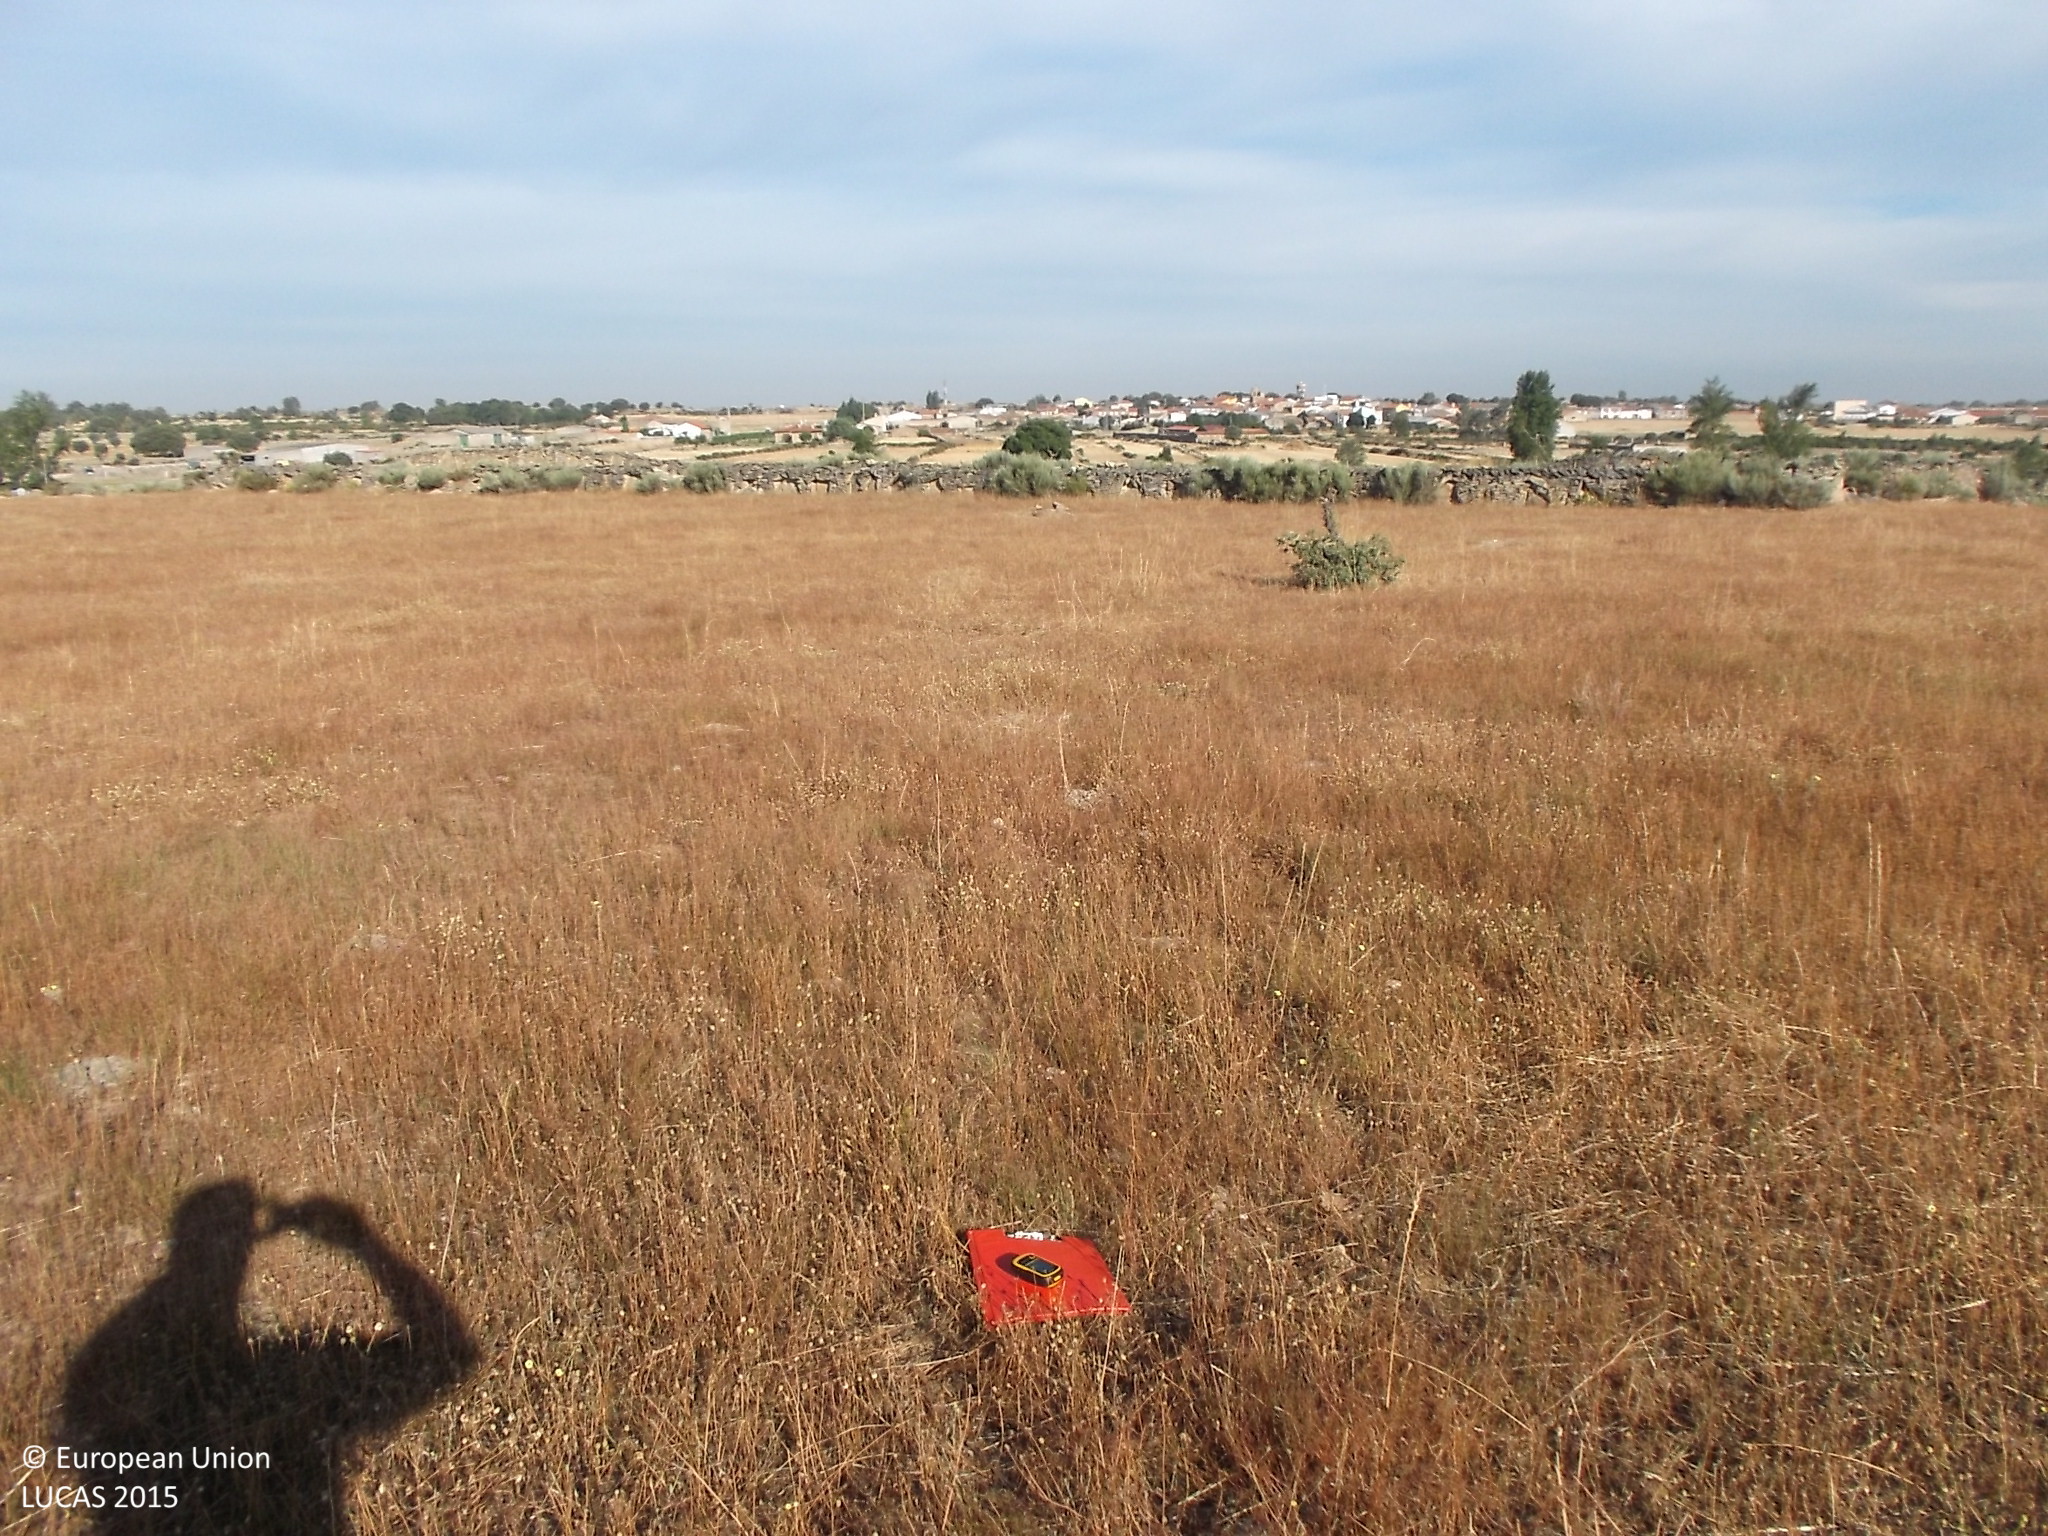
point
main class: Grassland
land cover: Grassland without tree/shrub cover
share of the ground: > 75 %
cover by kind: herbaceous plants 100 %
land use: Agriculture (excluding fallow land and kitchen gardens)
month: July
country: ES
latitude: 41.2261
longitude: -6.3308
